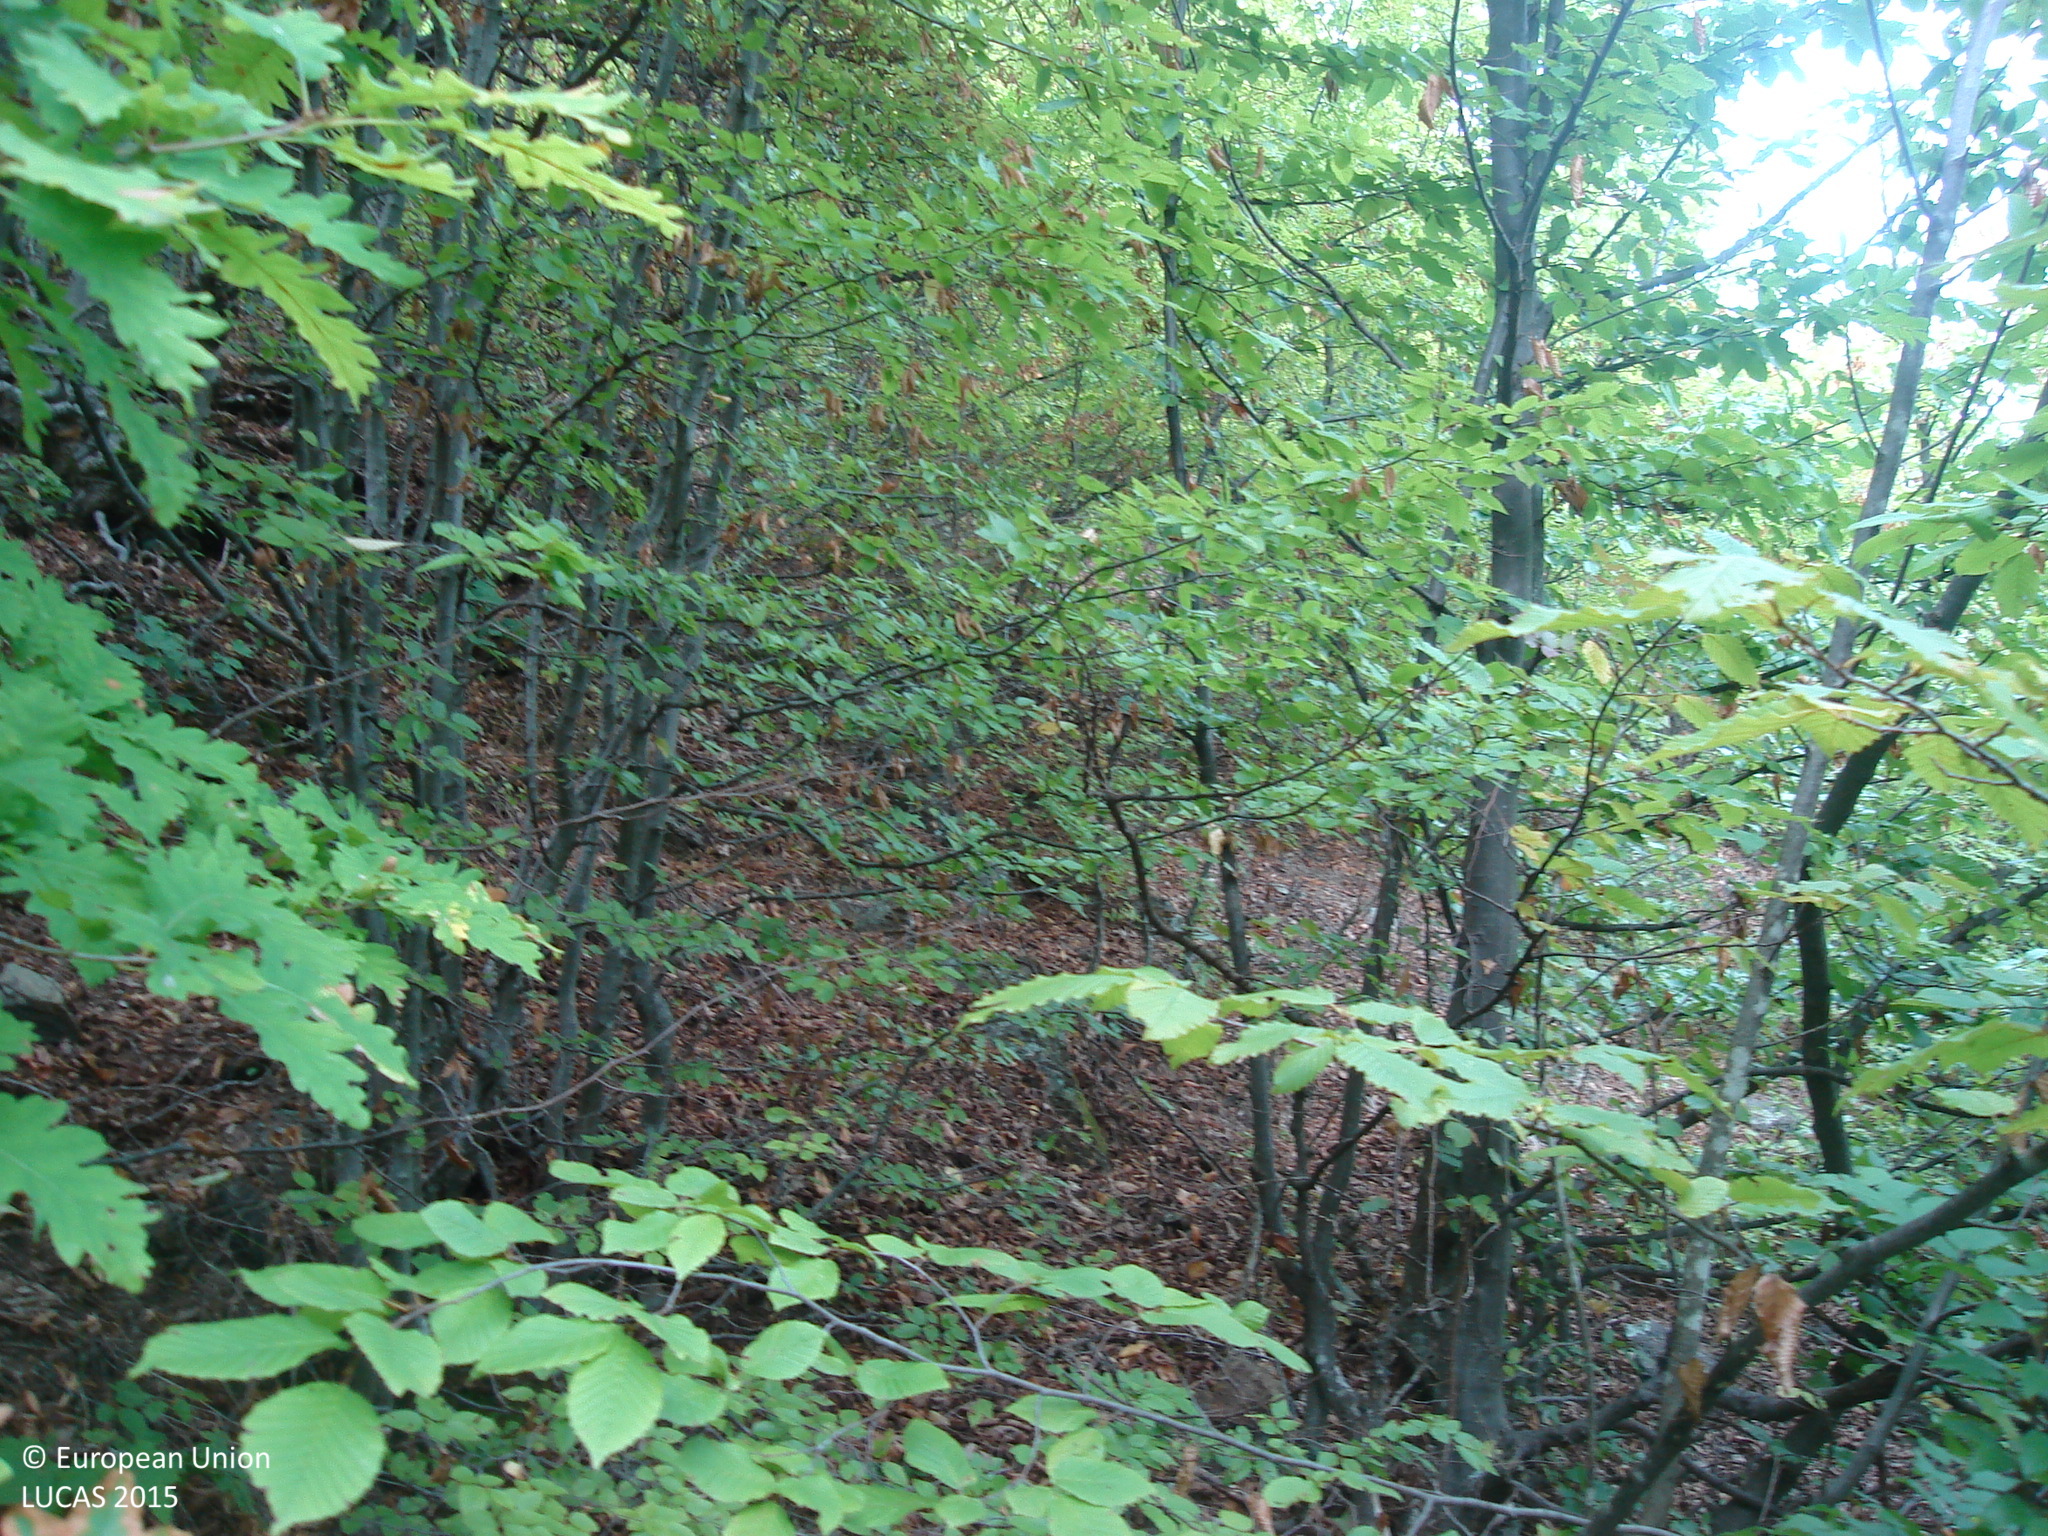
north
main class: Woodland
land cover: Broadleaved woodland
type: thermophilous deciduous forest
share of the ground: > 75 %
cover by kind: broadleaved forest trees 95 %, consolidated bare surface 5 %
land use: Forestry
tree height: > 5 m
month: September
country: BG
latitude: 43.0861
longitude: 23.3168
